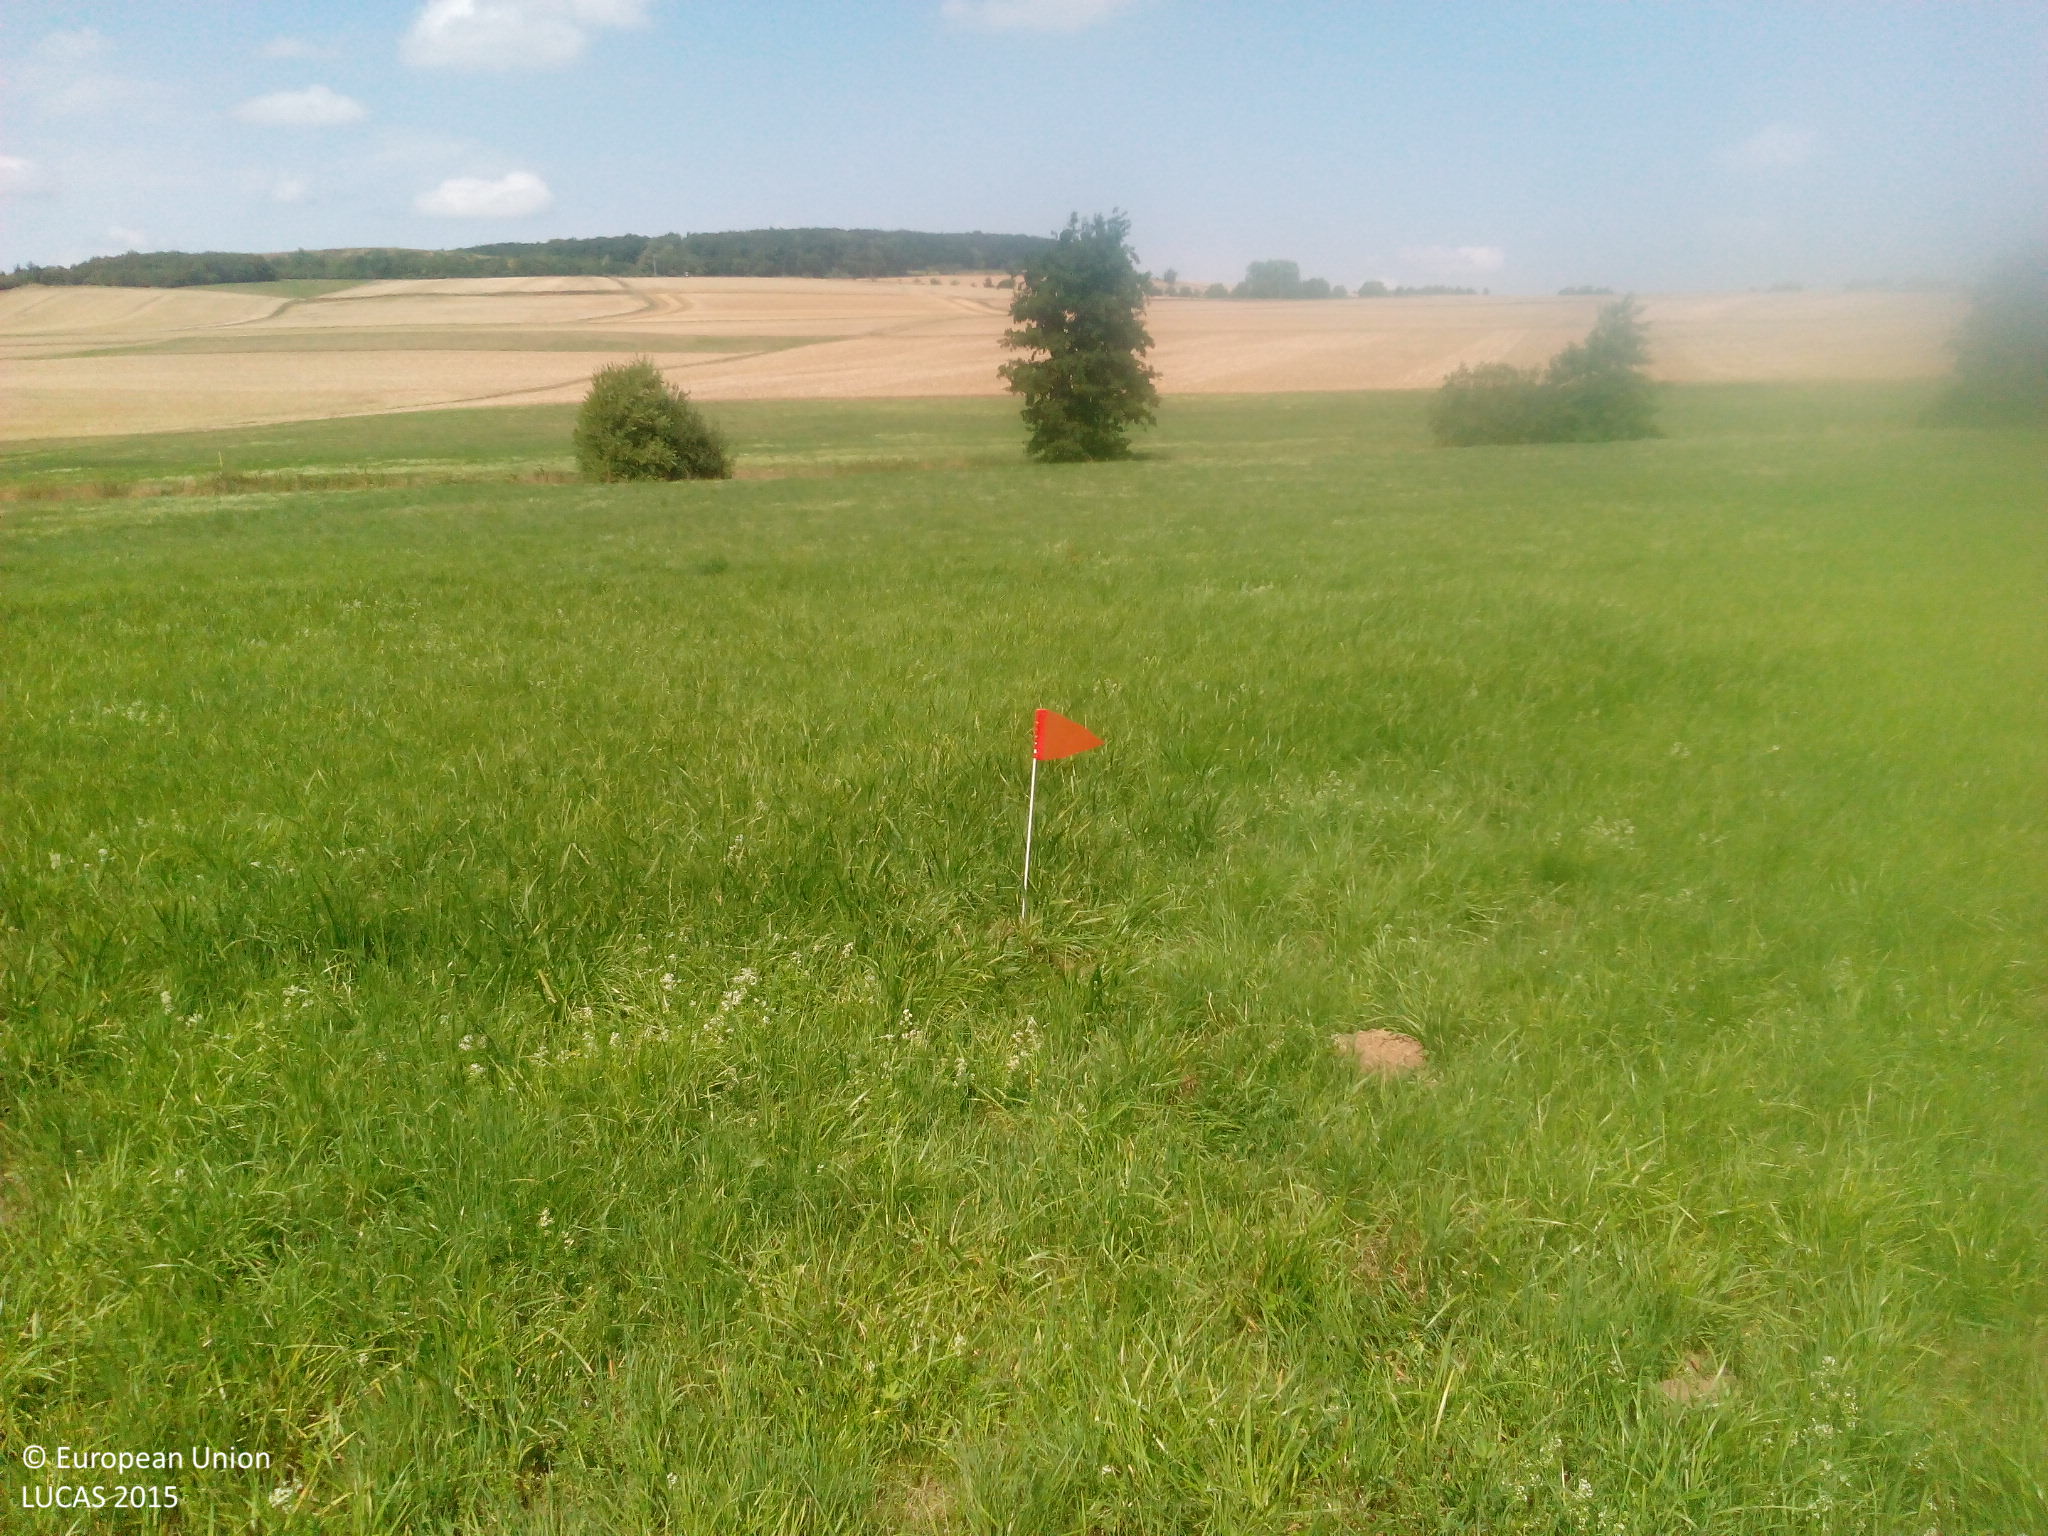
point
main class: Grassland
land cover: Grassland without tree/shrub cover
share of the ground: > 75 %
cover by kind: herbaceous plants 95 %, unconsolidated bare surface 5 %
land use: Agriculture (excluding fallow land and kitchen gardens)
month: August
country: DE
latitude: 50.3304
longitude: 8.1039
